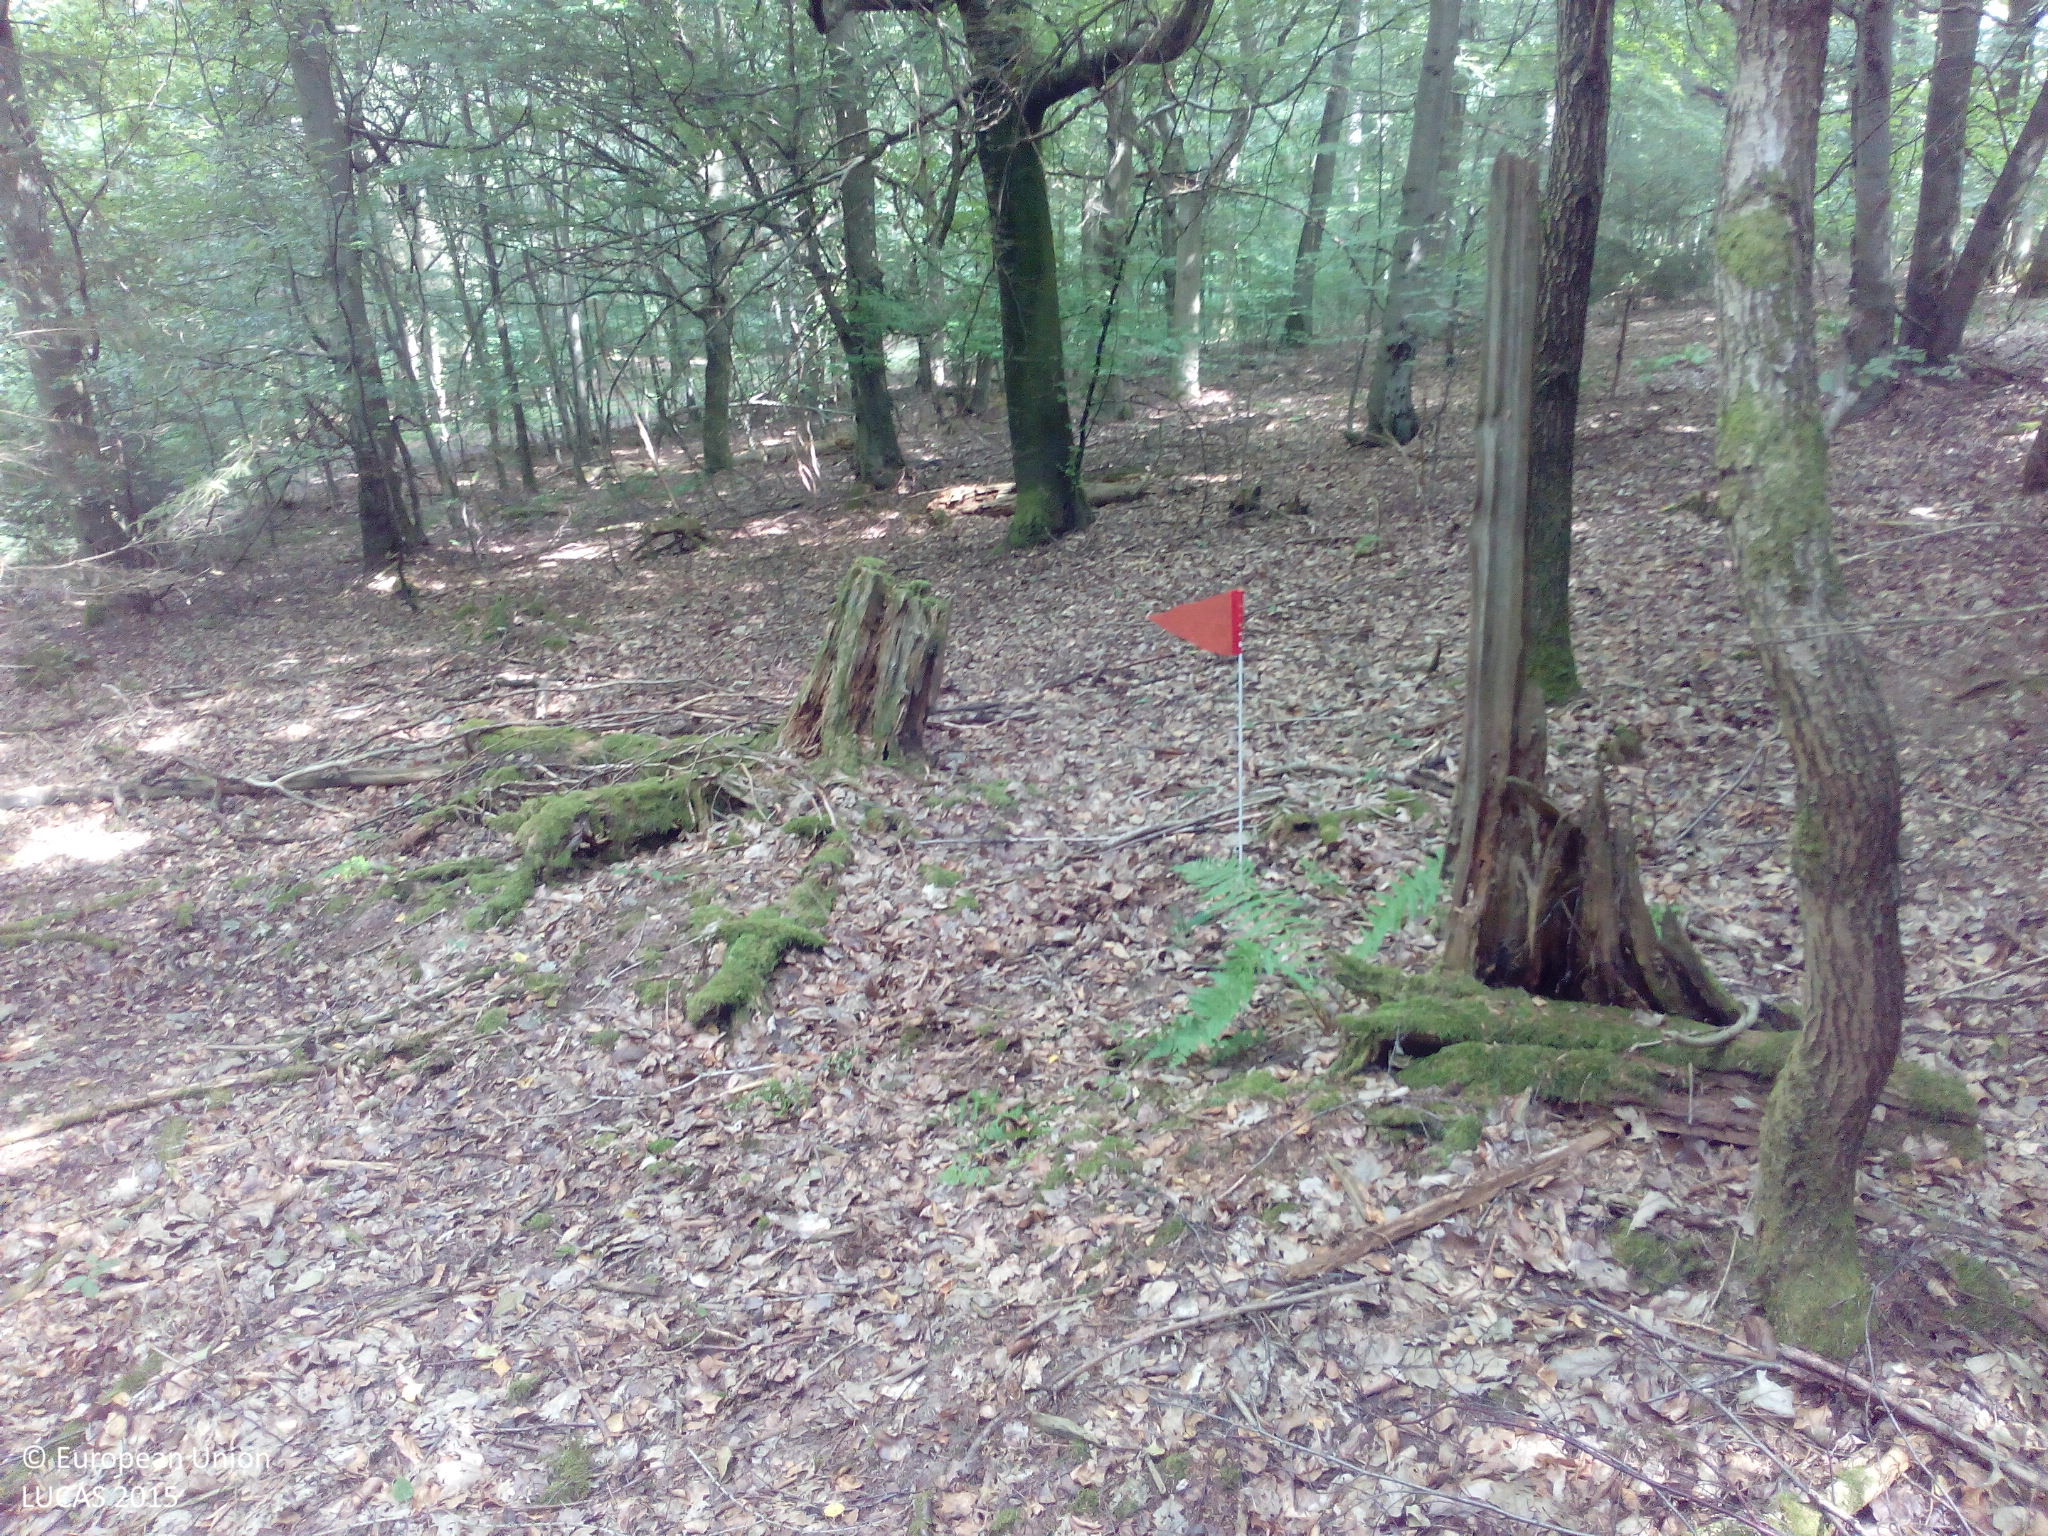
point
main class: Woodland
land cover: Spruce dominated mixed woodland
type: mesophytic deciduous forest
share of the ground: > 75 %
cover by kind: broadleaved forest trees 65 %, coniferous forest trees 25 %, lichens and mosses 5 %, unconsolidated bare surface 5 %
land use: Forestry
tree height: > 5 m
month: August
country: DE
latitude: 49.7254
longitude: 7.5173
